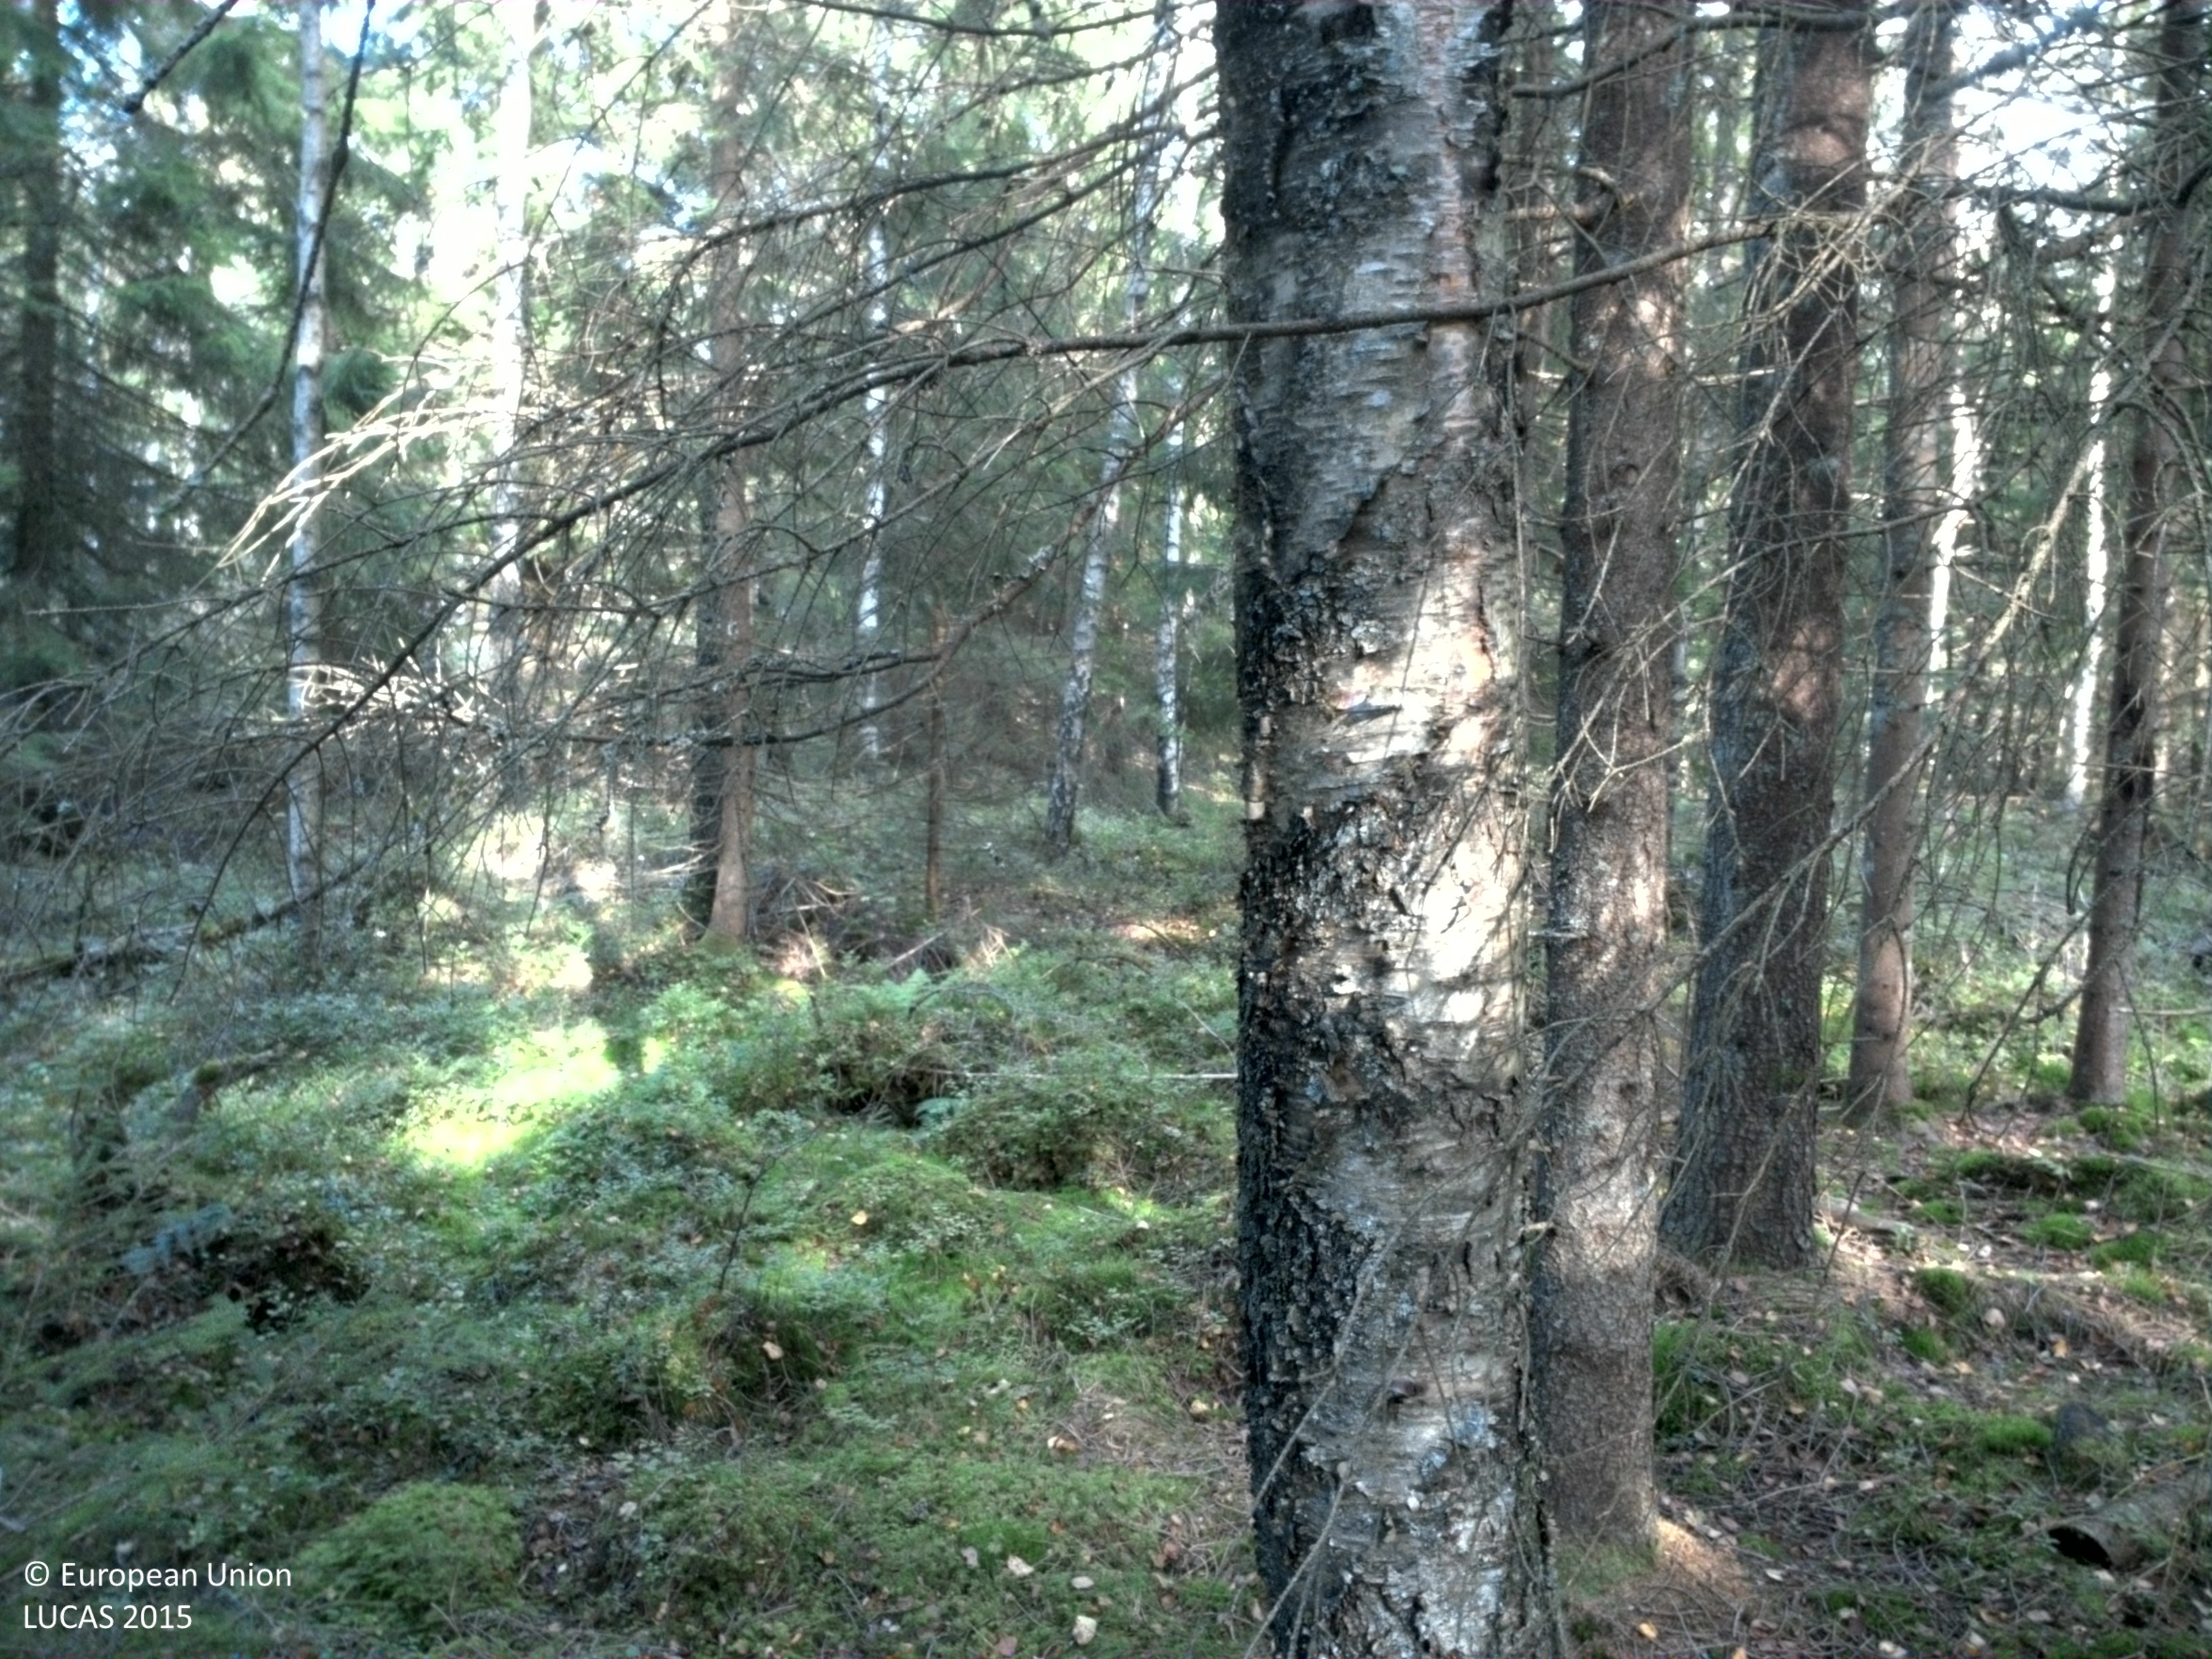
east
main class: Woodland
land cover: Spruce dominated mixed woodland
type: boreal forest
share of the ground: 50 - 75 %
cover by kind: coniferous forest trees 40 %, broadleaved forest trees 20 %, shrubs 20 %, lichens and mosses 20 %
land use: Forestry
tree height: > 5 m
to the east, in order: Spruce dominated mixed woodland; Pine dominated mixed woodland; Pine dominated coniferous woodland; Spruce dominated mixed woodland
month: September
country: SE
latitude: 57.8970
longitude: 13.0488
